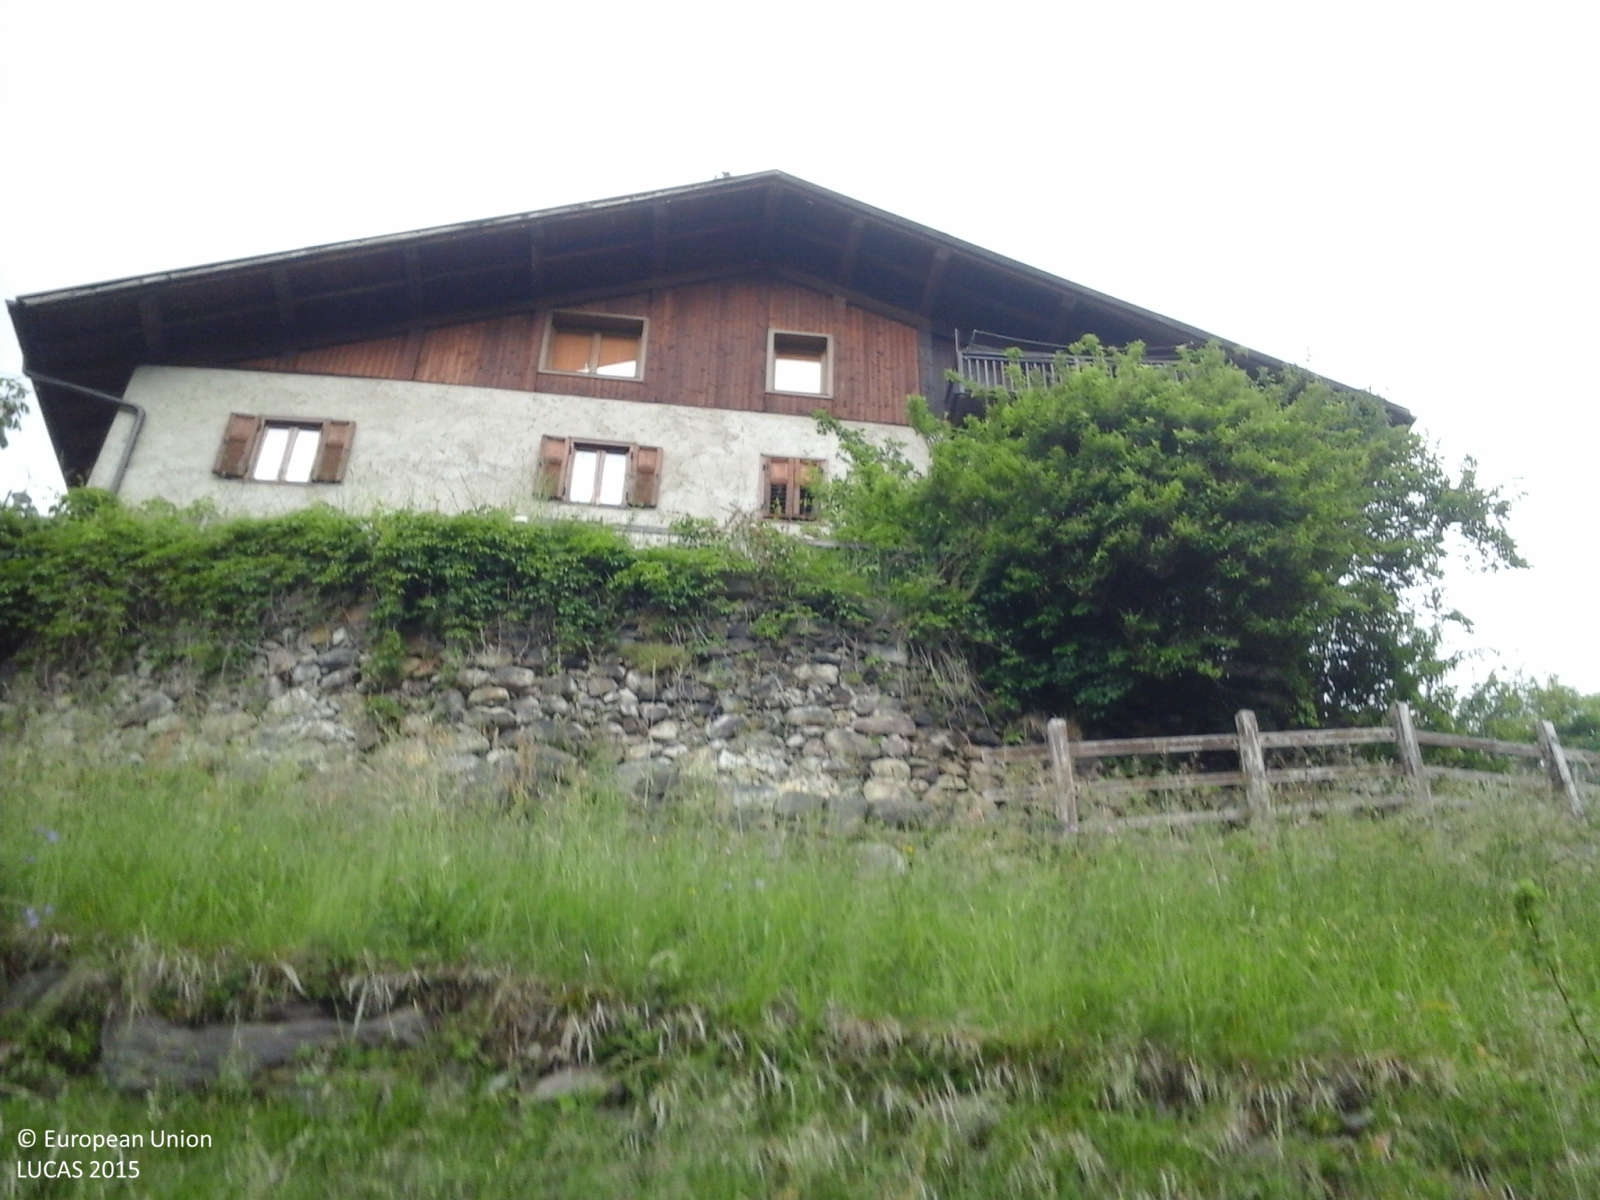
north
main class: Grassland
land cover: Grassland without tree/shrub cover
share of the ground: 50 - 75 %
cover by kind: herbaceous plants 70 %, consolidated bare surface 30 %
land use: Semi-natural and natural areas not in use
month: May
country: IT
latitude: 46.1568
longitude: 11.7458
